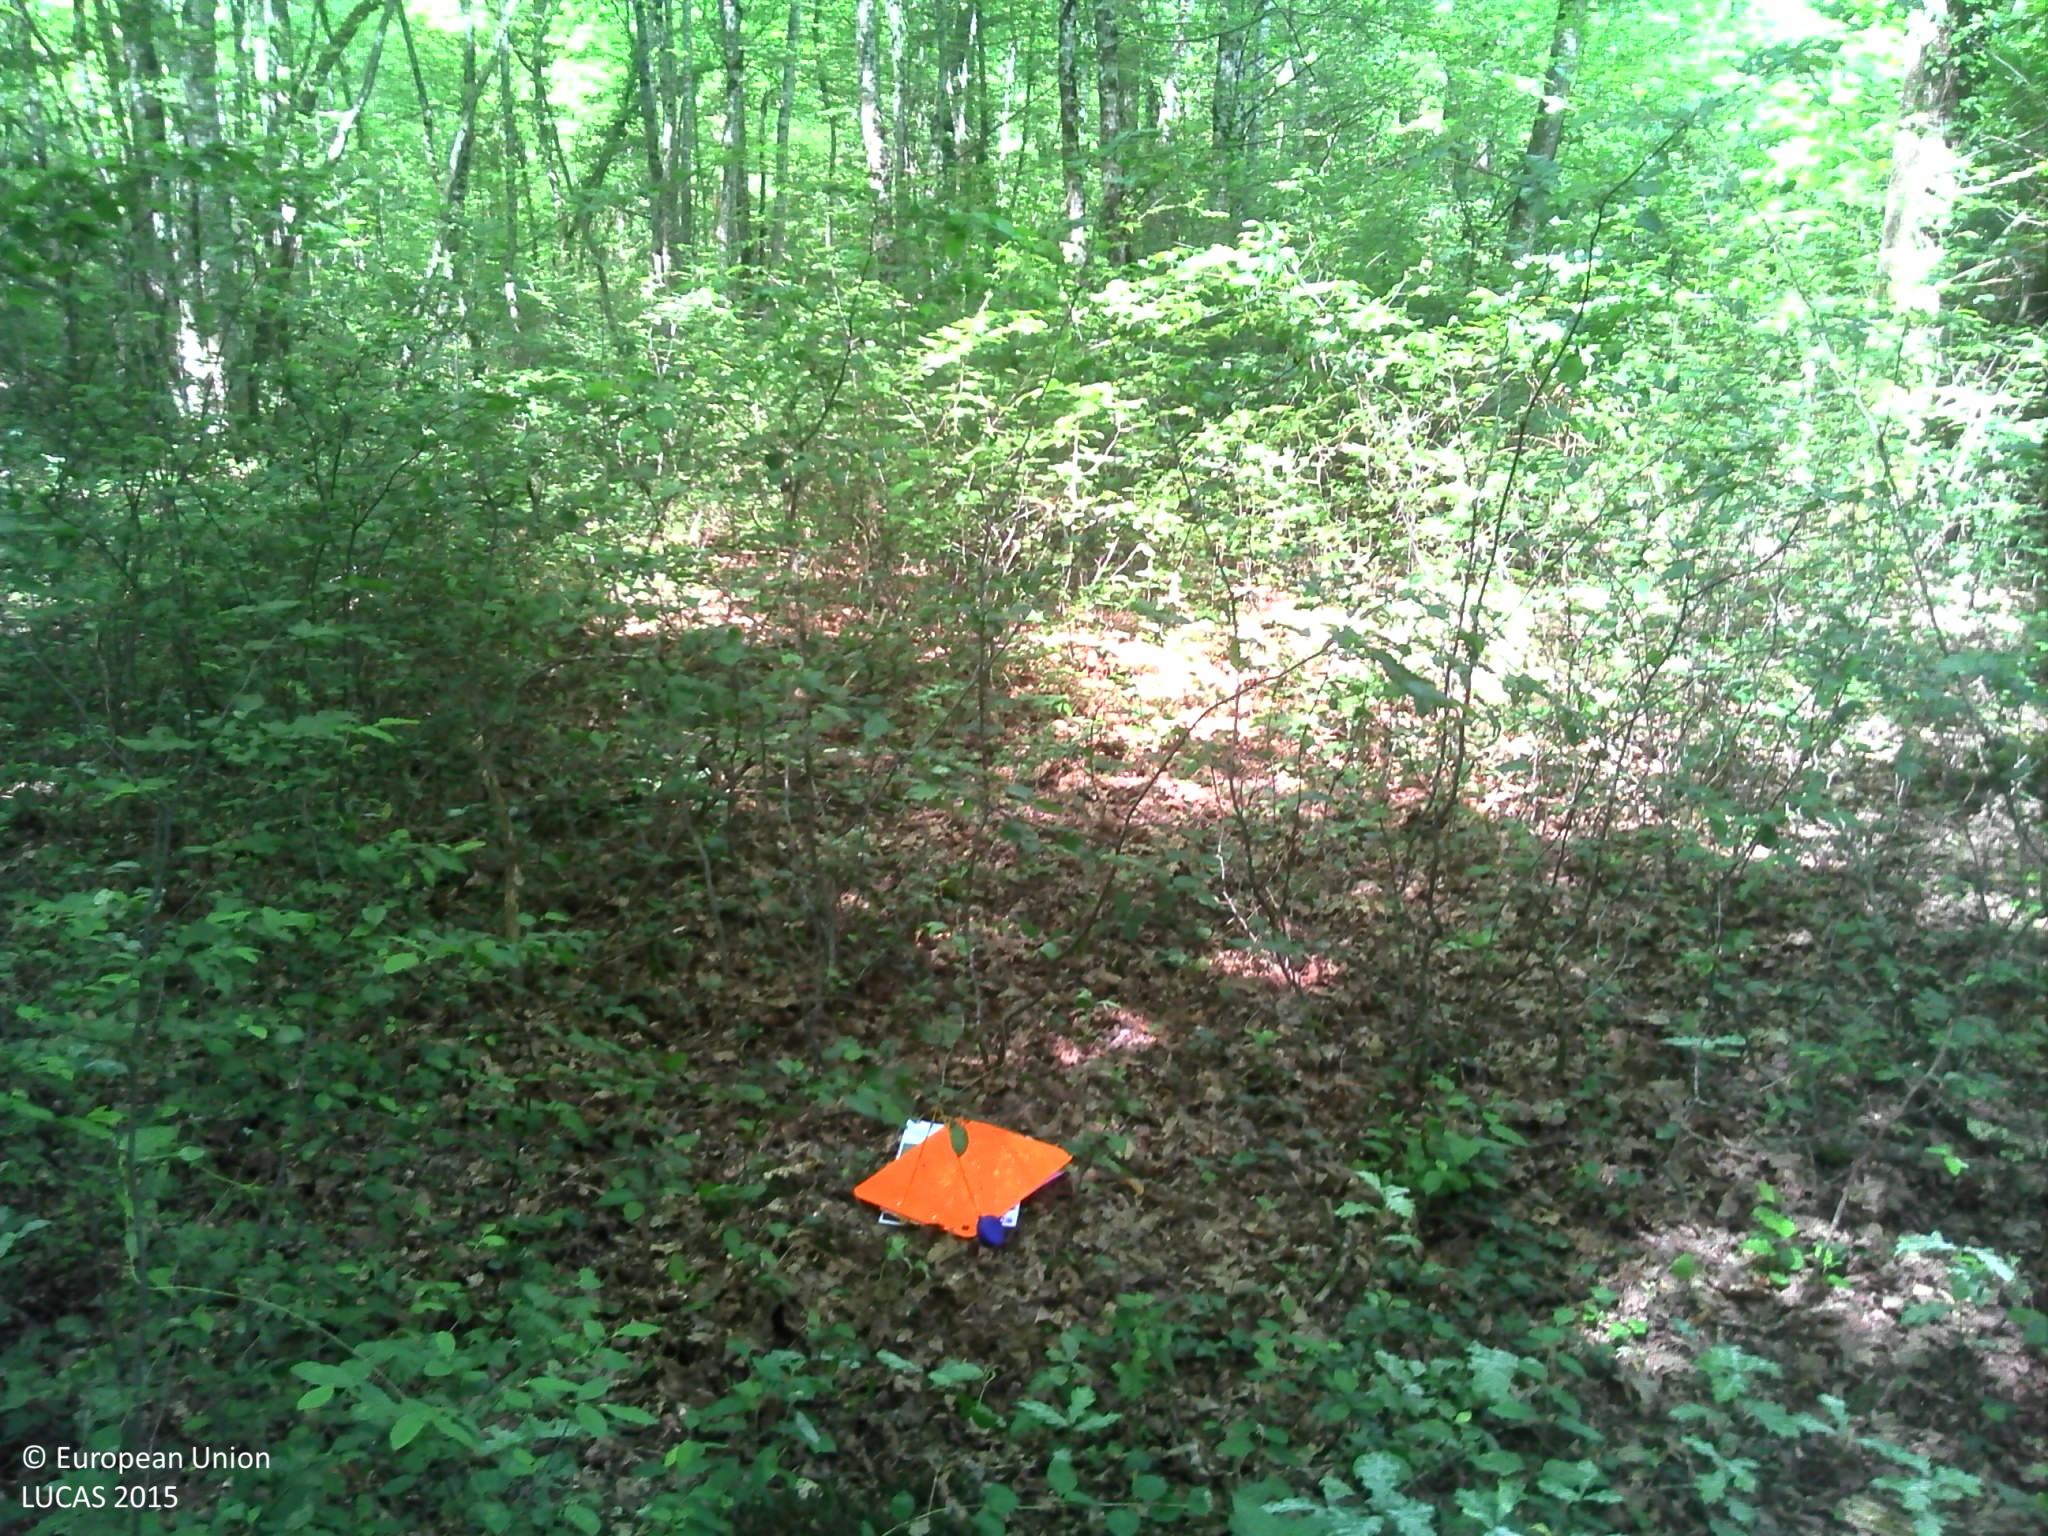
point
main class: Woodland
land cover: Broadleaved woodland
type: mesophytic deciduous forest
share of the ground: > 75 %
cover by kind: broadleaved forest trees 95 %, herbaceous plants 5 %
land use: Forestry
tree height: > 5 m
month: June
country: FR
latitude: 47.7516
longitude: 2.5082
